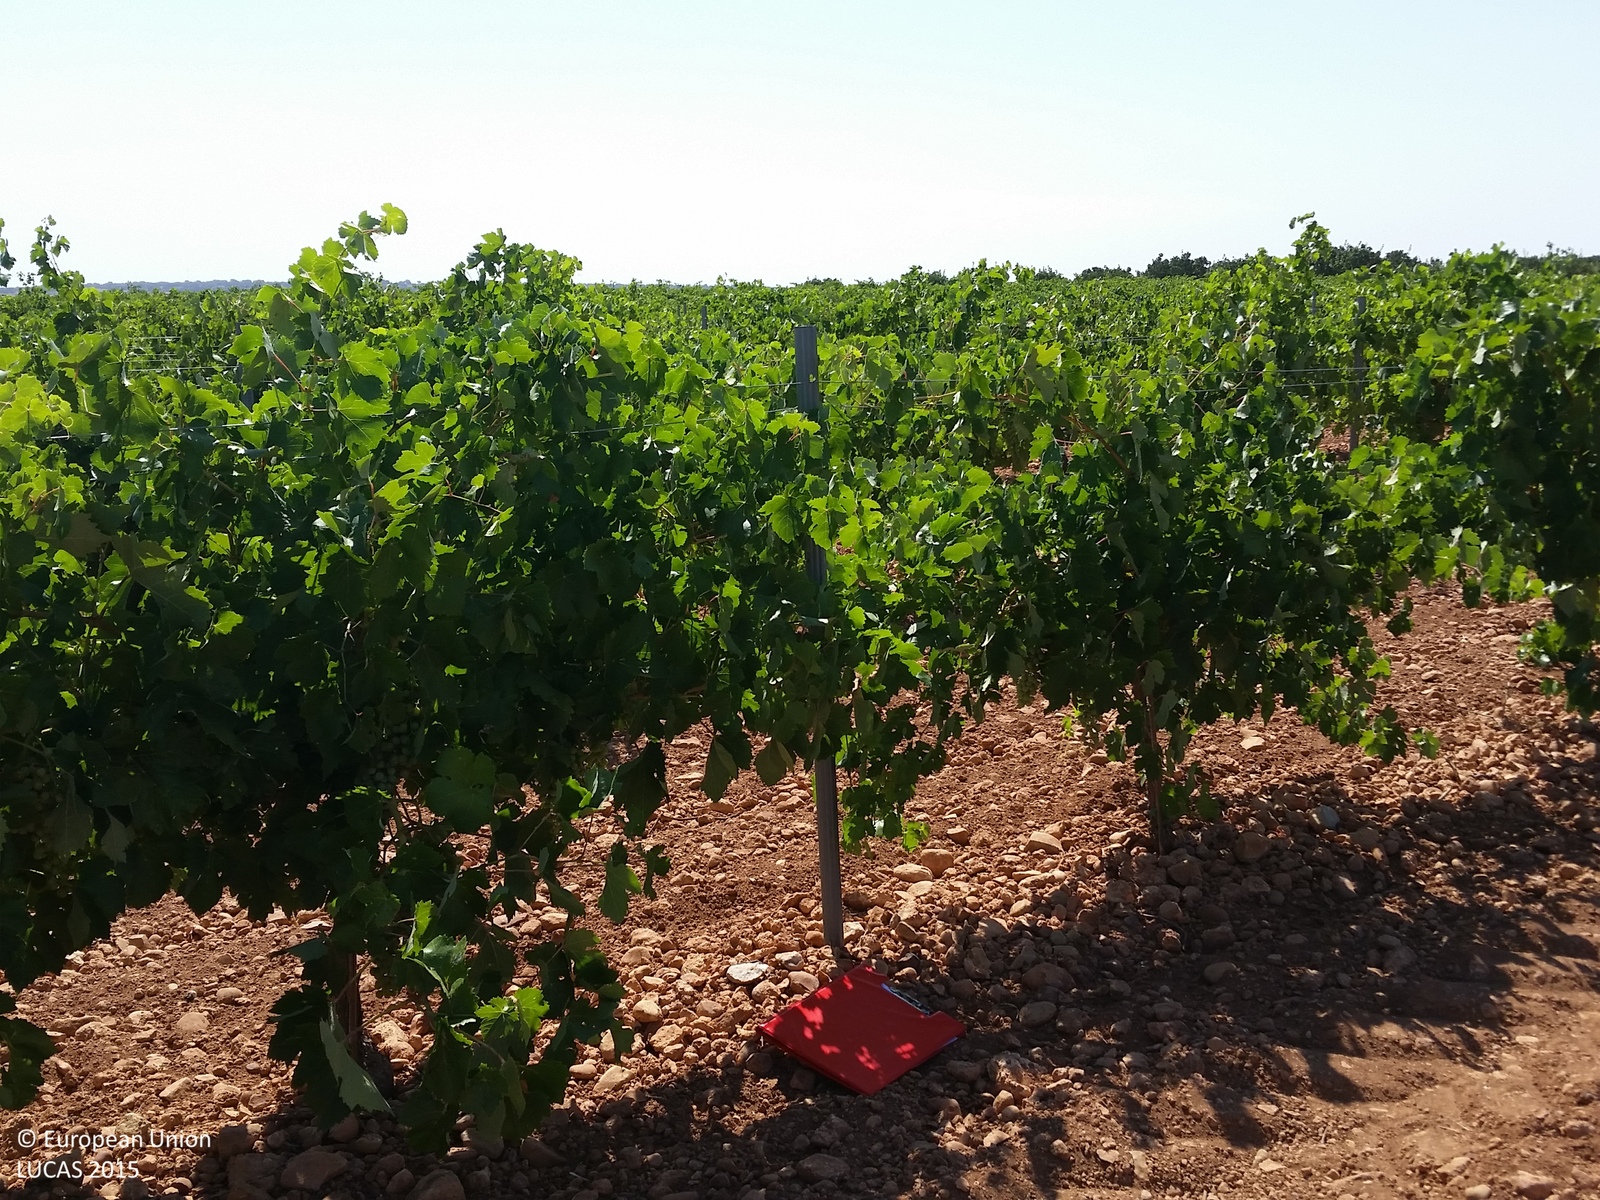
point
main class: Cropland
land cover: Vineyards
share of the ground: 50 - 75 %
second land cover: Other bare soil
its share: > 75 %
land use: Agriculture (excluding fallow land and kitchen gardens)
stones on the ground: 10 - 25 %
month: July
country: ES
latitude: 39.2168
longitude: -2.5758
